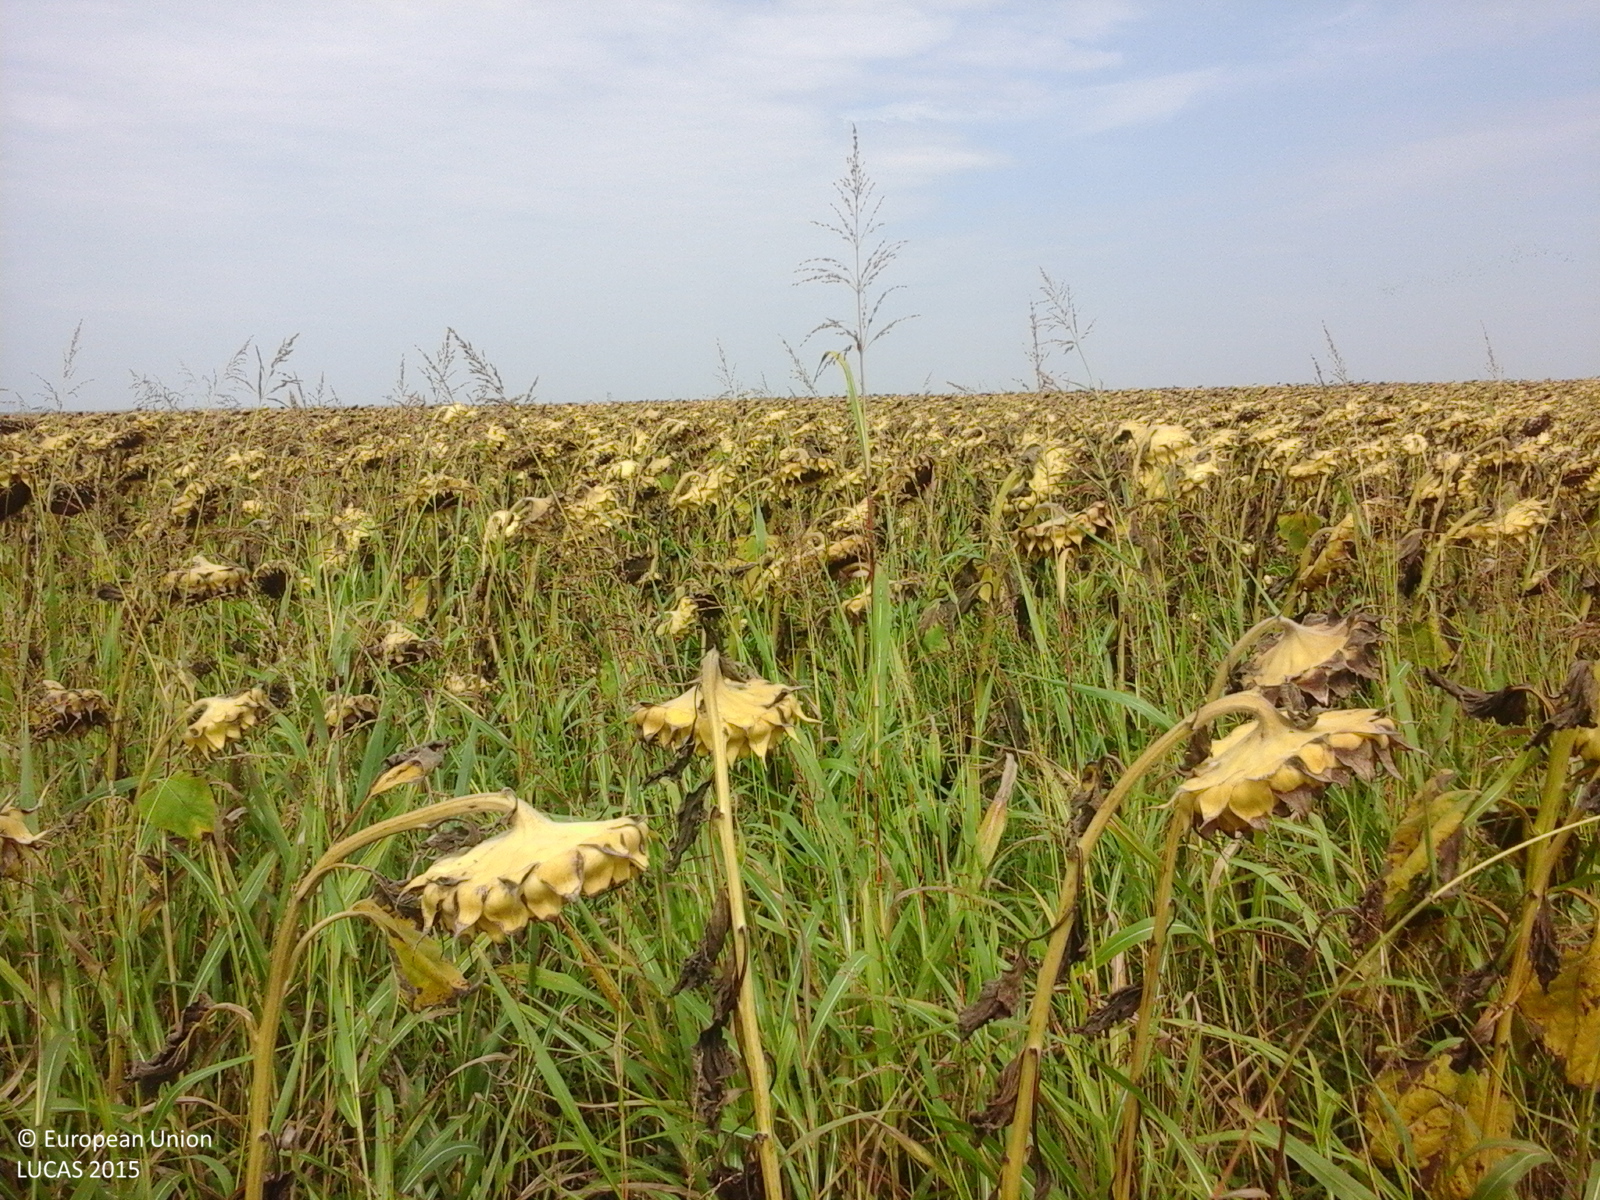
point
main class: Cropland
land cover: Sunflower
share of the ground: > 75 %
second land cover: Spontaneously vegetated surfaces
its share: > 75 %
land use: Agriculture (excluding fallow land and kitchen gardens)
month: August
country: RO
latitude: 46.2230
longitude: 20.7757
